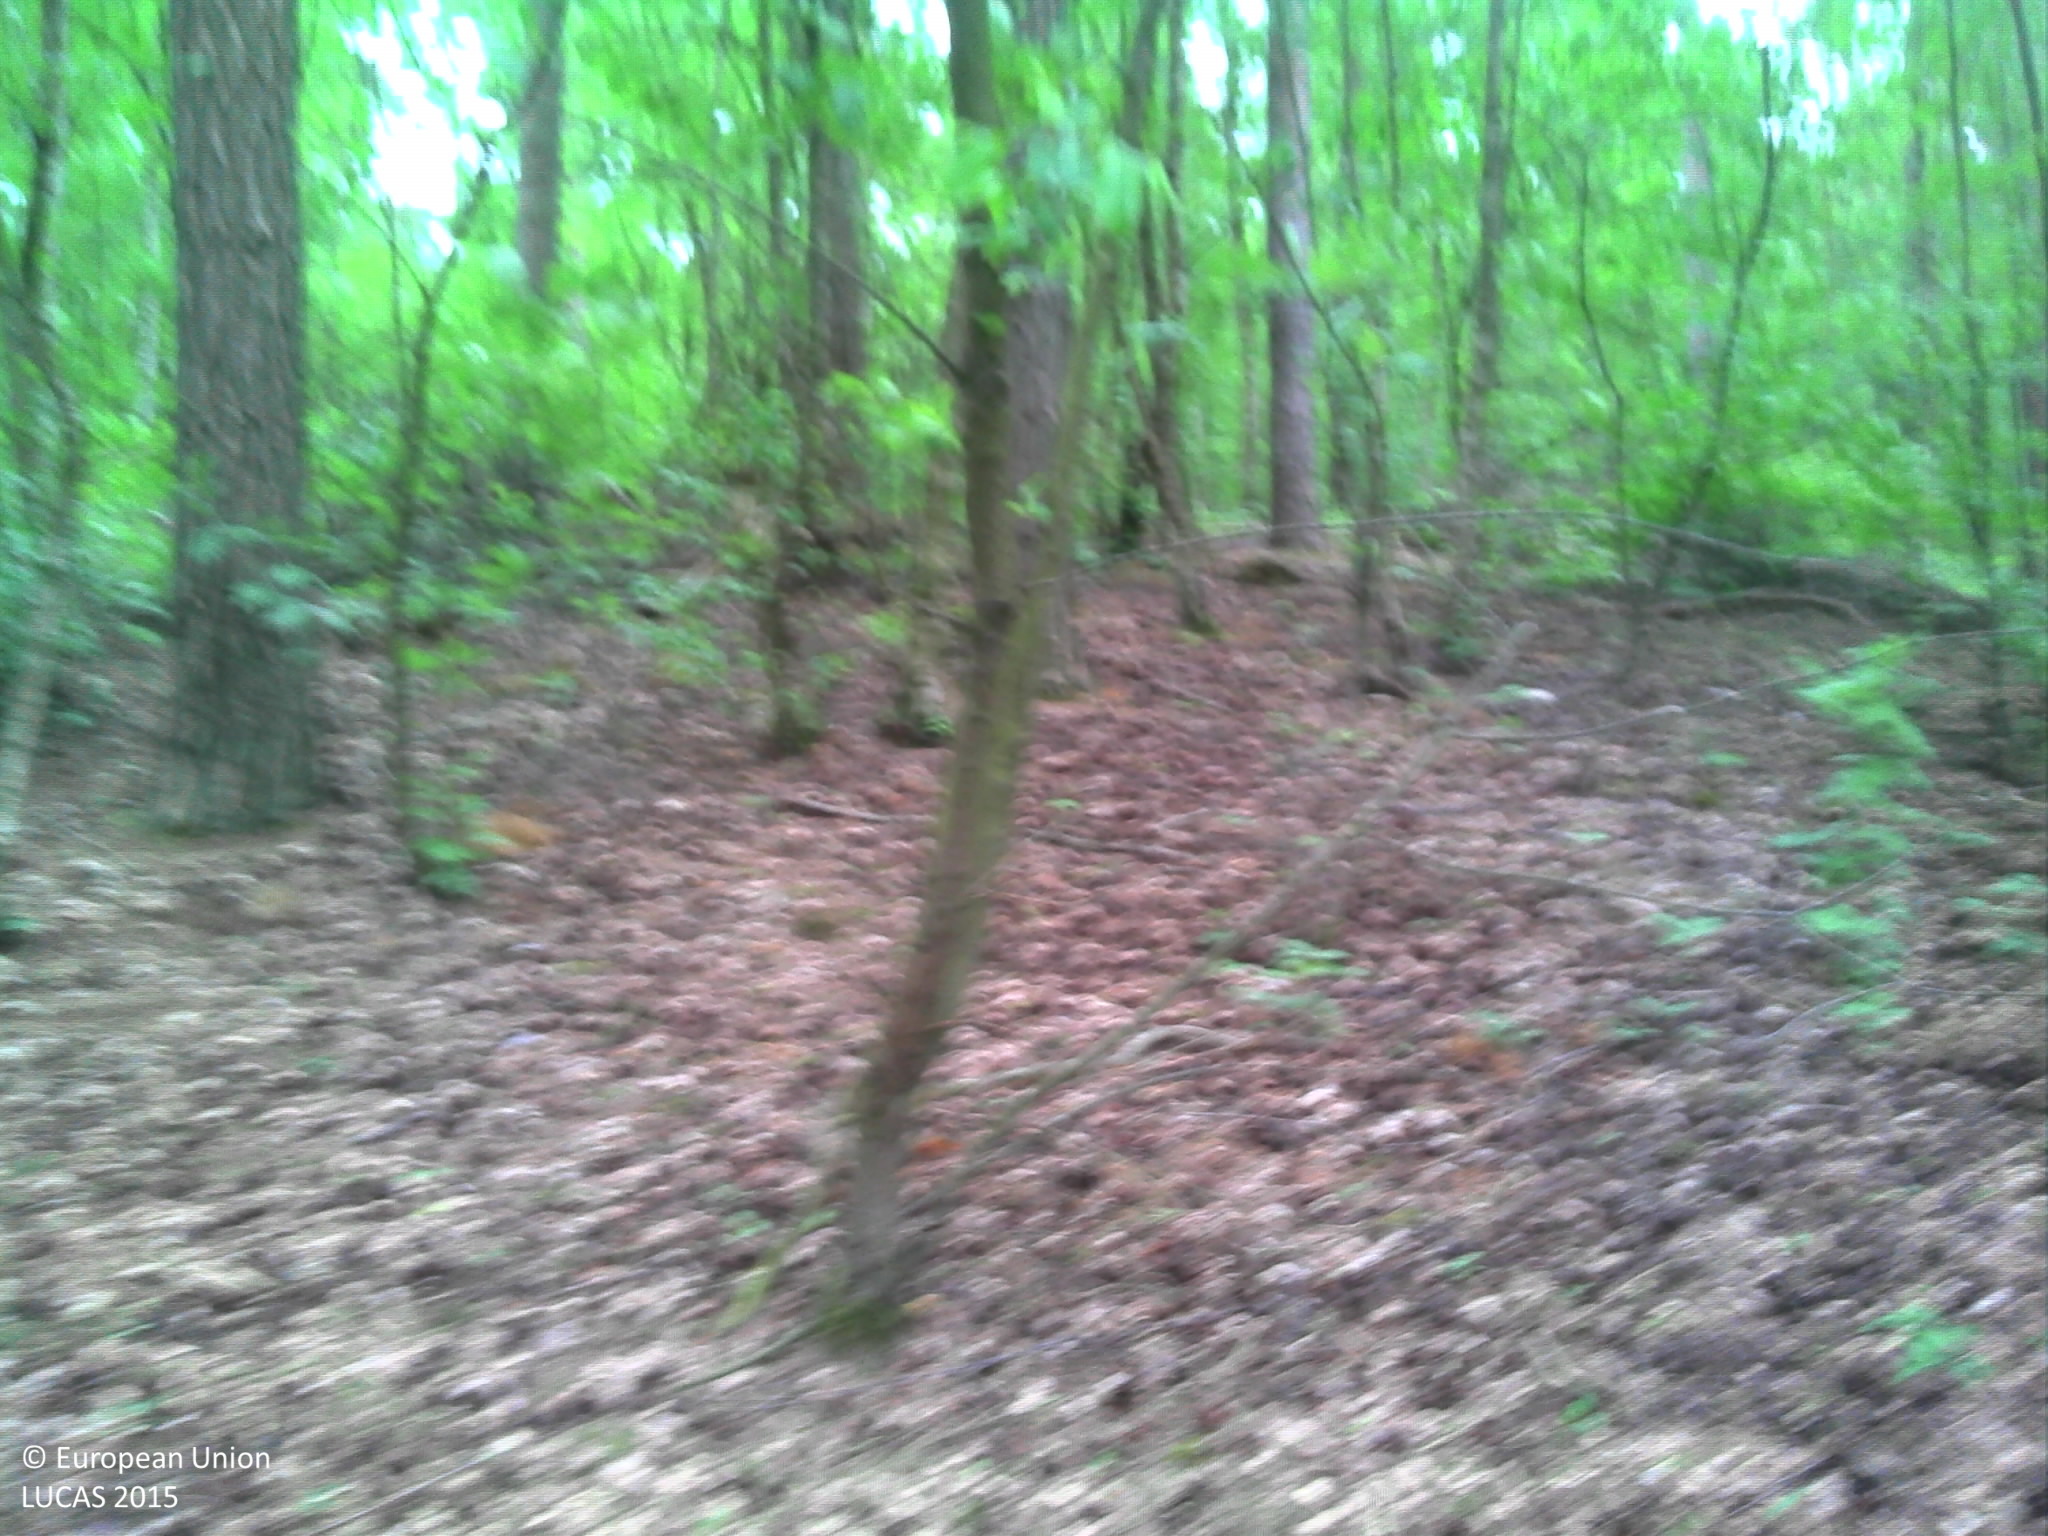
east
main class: Woodland
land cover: Pine dominated coniferous woodland
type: exotic forest
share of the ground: > 75 %
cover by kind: coniferous forest trees 100 %
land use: Forestry
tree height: > 5 m
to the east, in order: Pine dominated coniferous woodland; Tracks; Pine dominated coniferous woodland; Tracks; Pine dominated coniferous woodland
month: May
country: BE
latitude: 50.7204
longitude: 4.5426
